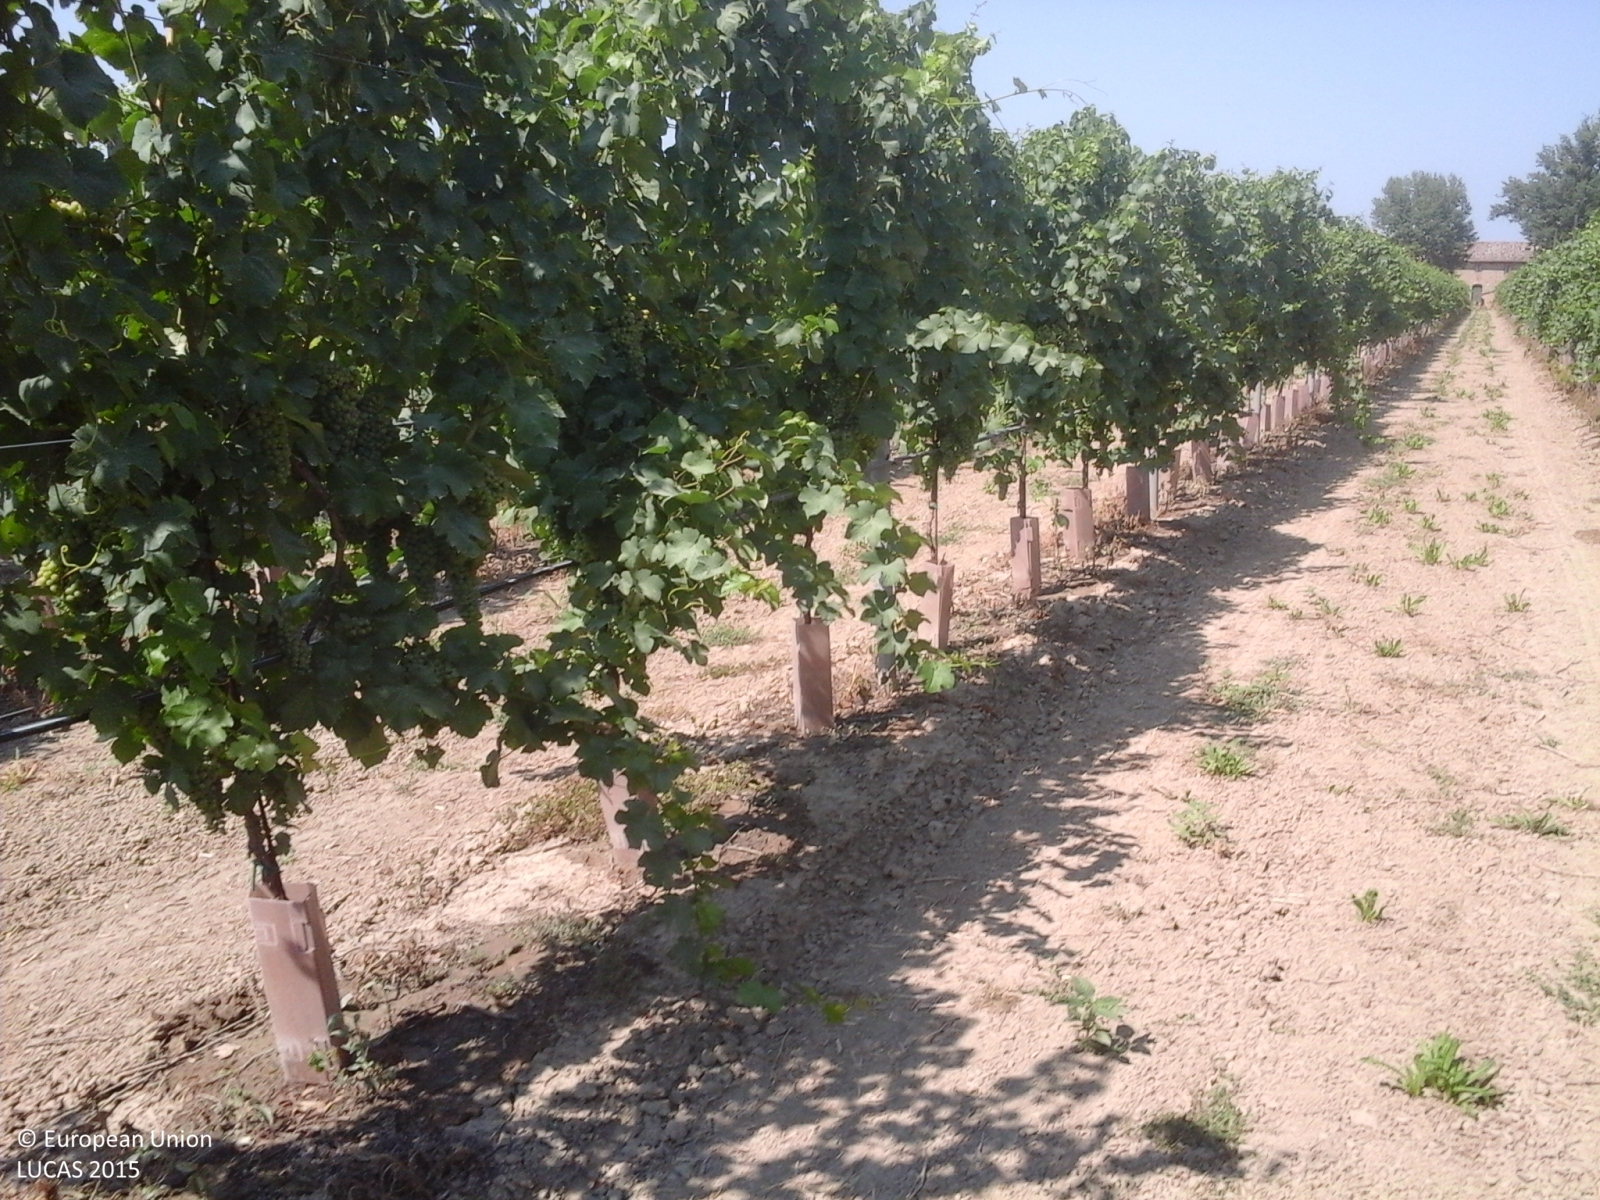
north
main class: Cropland
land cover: Vineyards
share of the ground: 50 - 75 %
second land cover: Other bare soil
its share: > 75 %
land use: Agriculture (excluding fallow land and kitchen gardens)
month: July
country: IT
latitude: 44.4240
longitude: 11.8675
